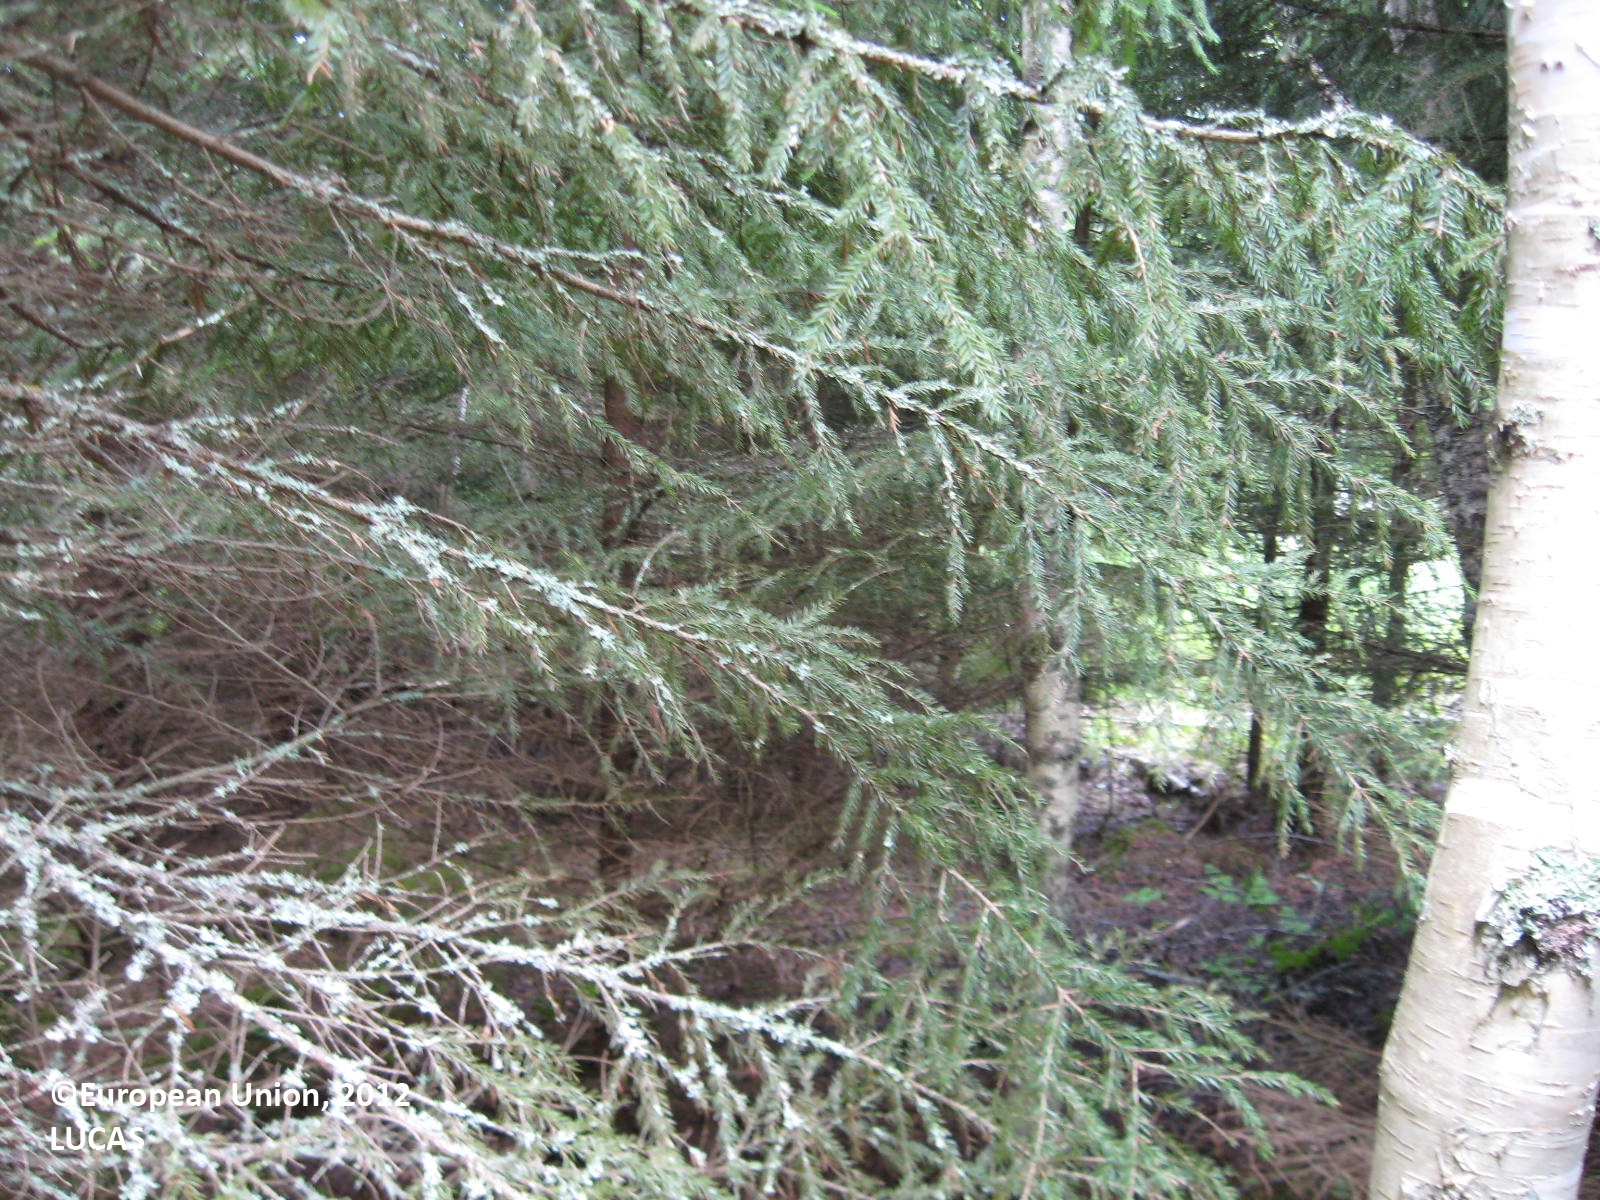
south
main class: Woodland
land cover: Spruce dominated mixed woodland
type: boreal forest
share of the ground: > 75 %
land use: Forestry
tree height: > 5 m
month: July
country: FI
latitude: 62.3529
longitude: 21.4997
